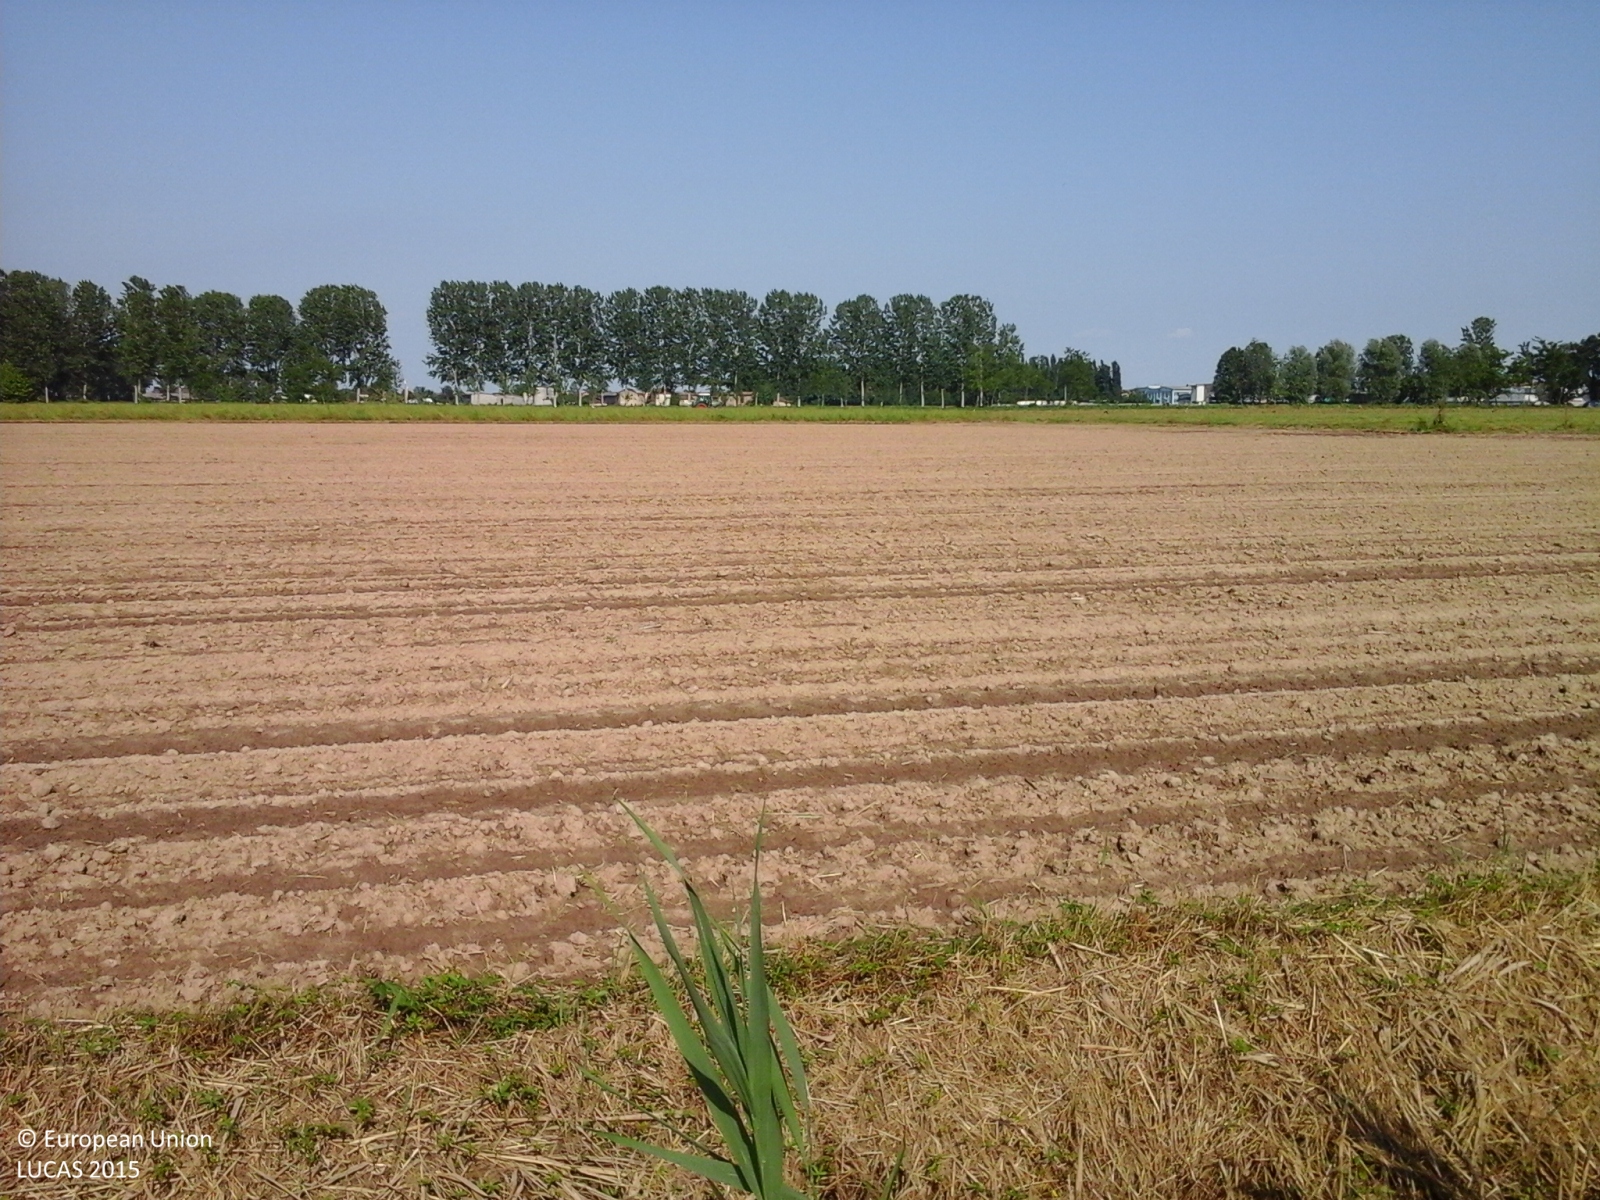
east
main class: Cropland
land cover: Maize
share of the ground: 25 - 50 %
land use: Agriculture (excluding fallow land and kitchen gardens)
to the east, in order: Maize; Grass margins; Ditches and canals; Grass margins; Temporary grasslands; Maize
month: May
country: IT
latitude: 45.3415
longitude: 9.6306
